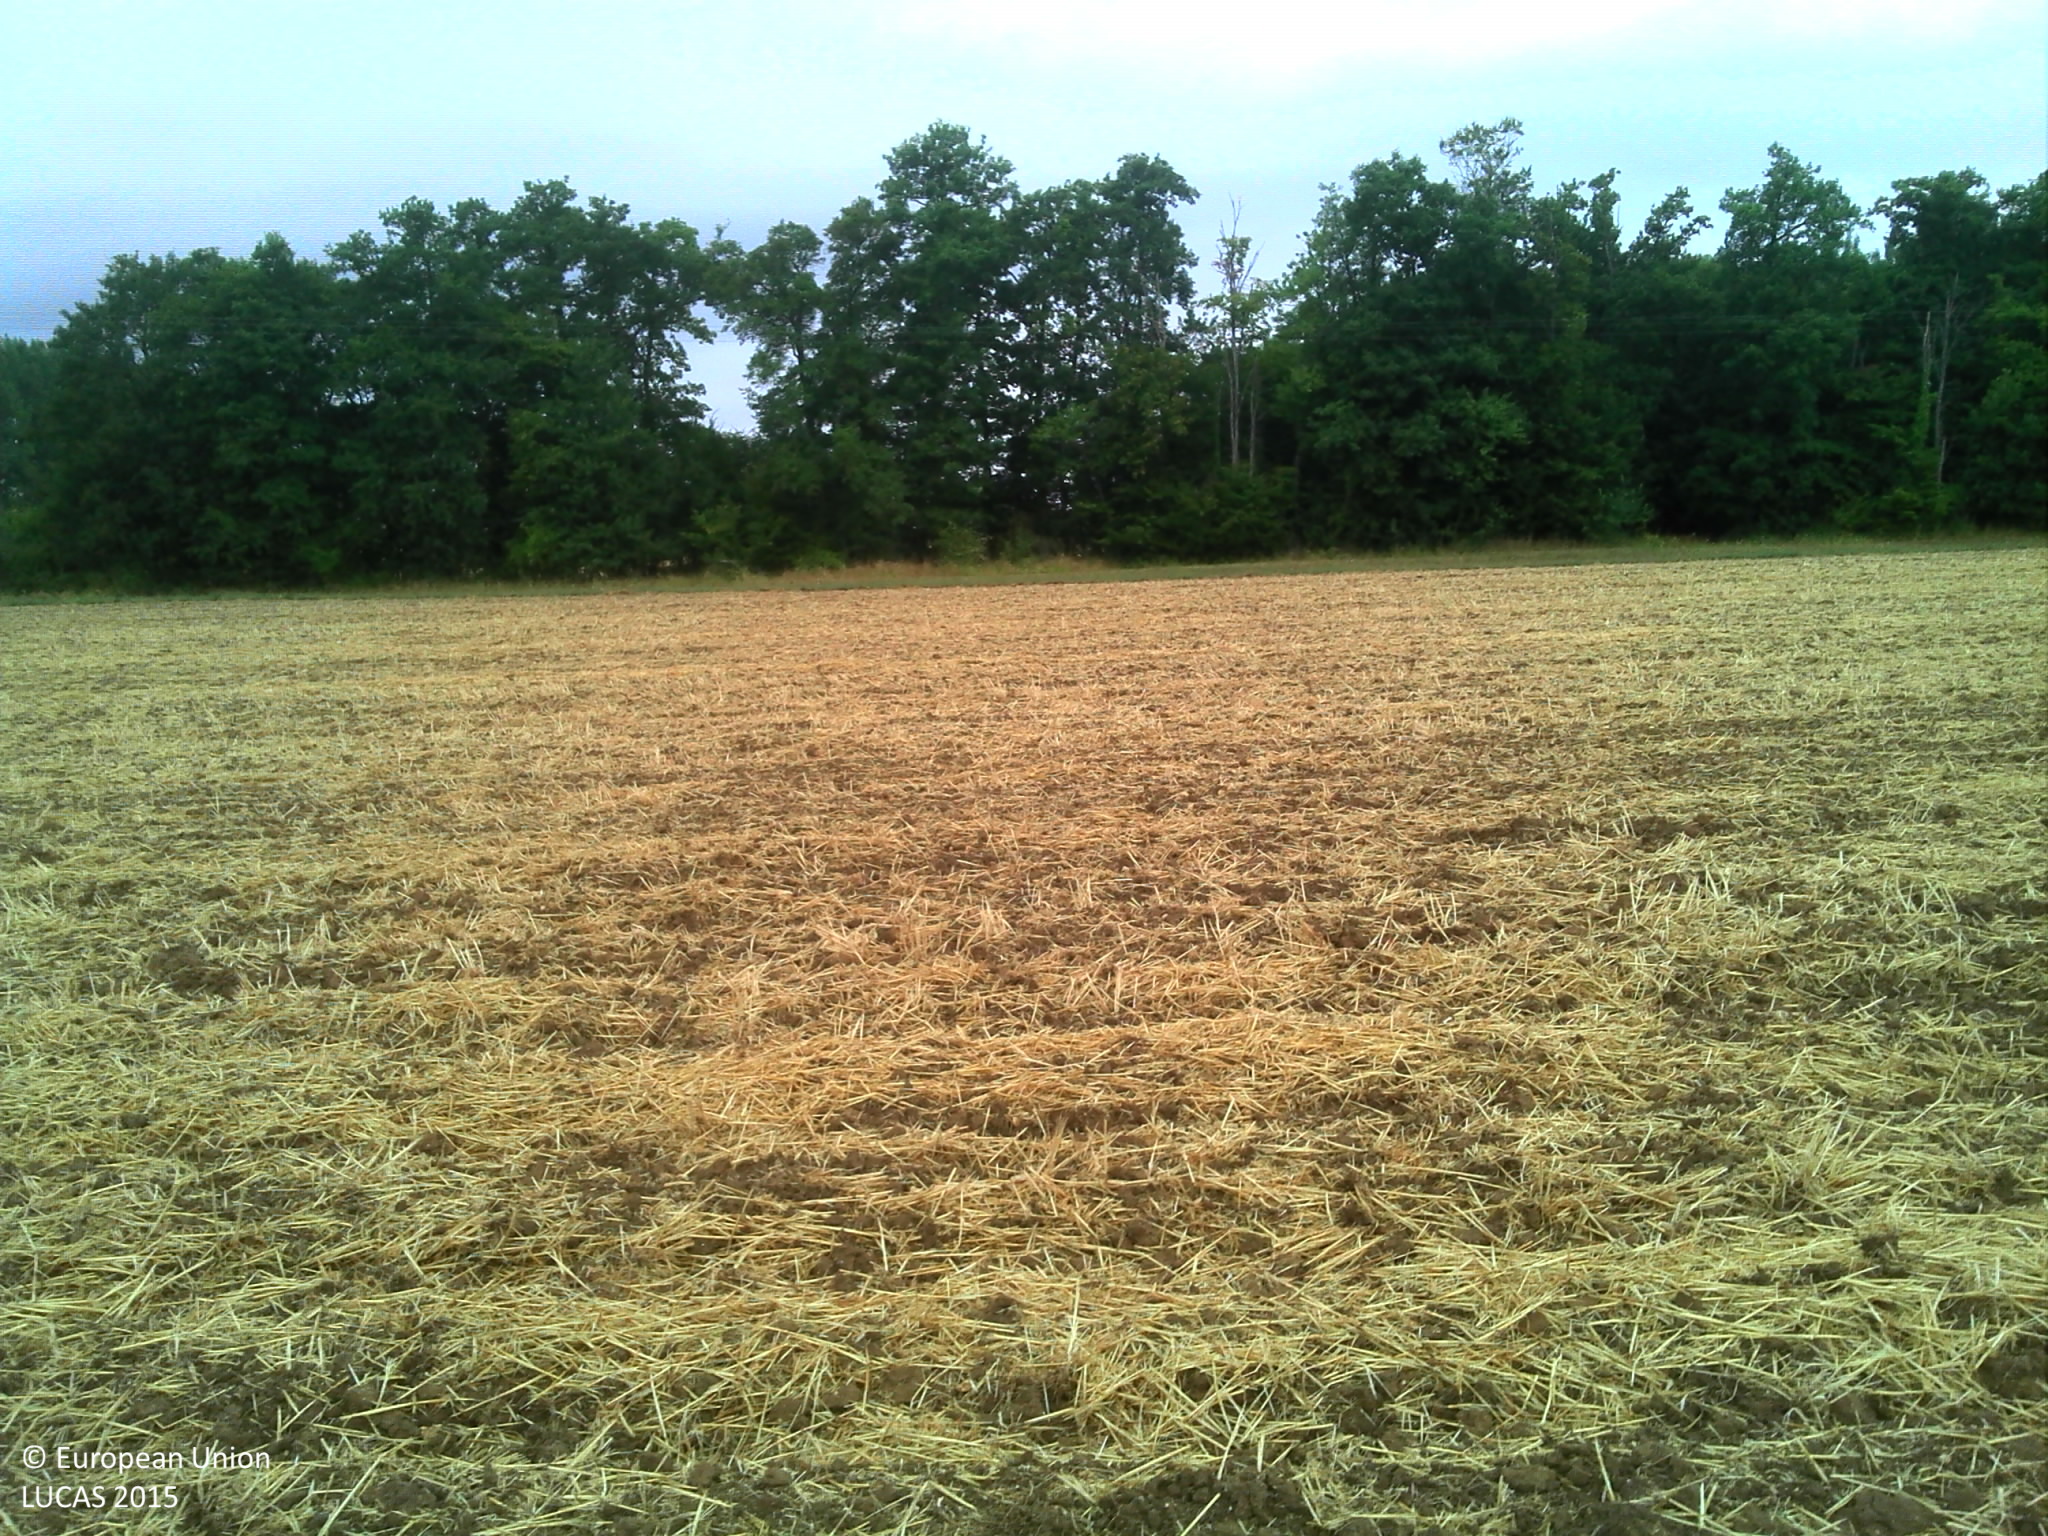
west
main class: Cropland
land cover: Common wheat
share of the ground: > 75 %
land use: Agriculture (excluding fallow land and kitchen gardens)
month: August
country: FR
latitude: 48.5279
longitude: 3.3446
